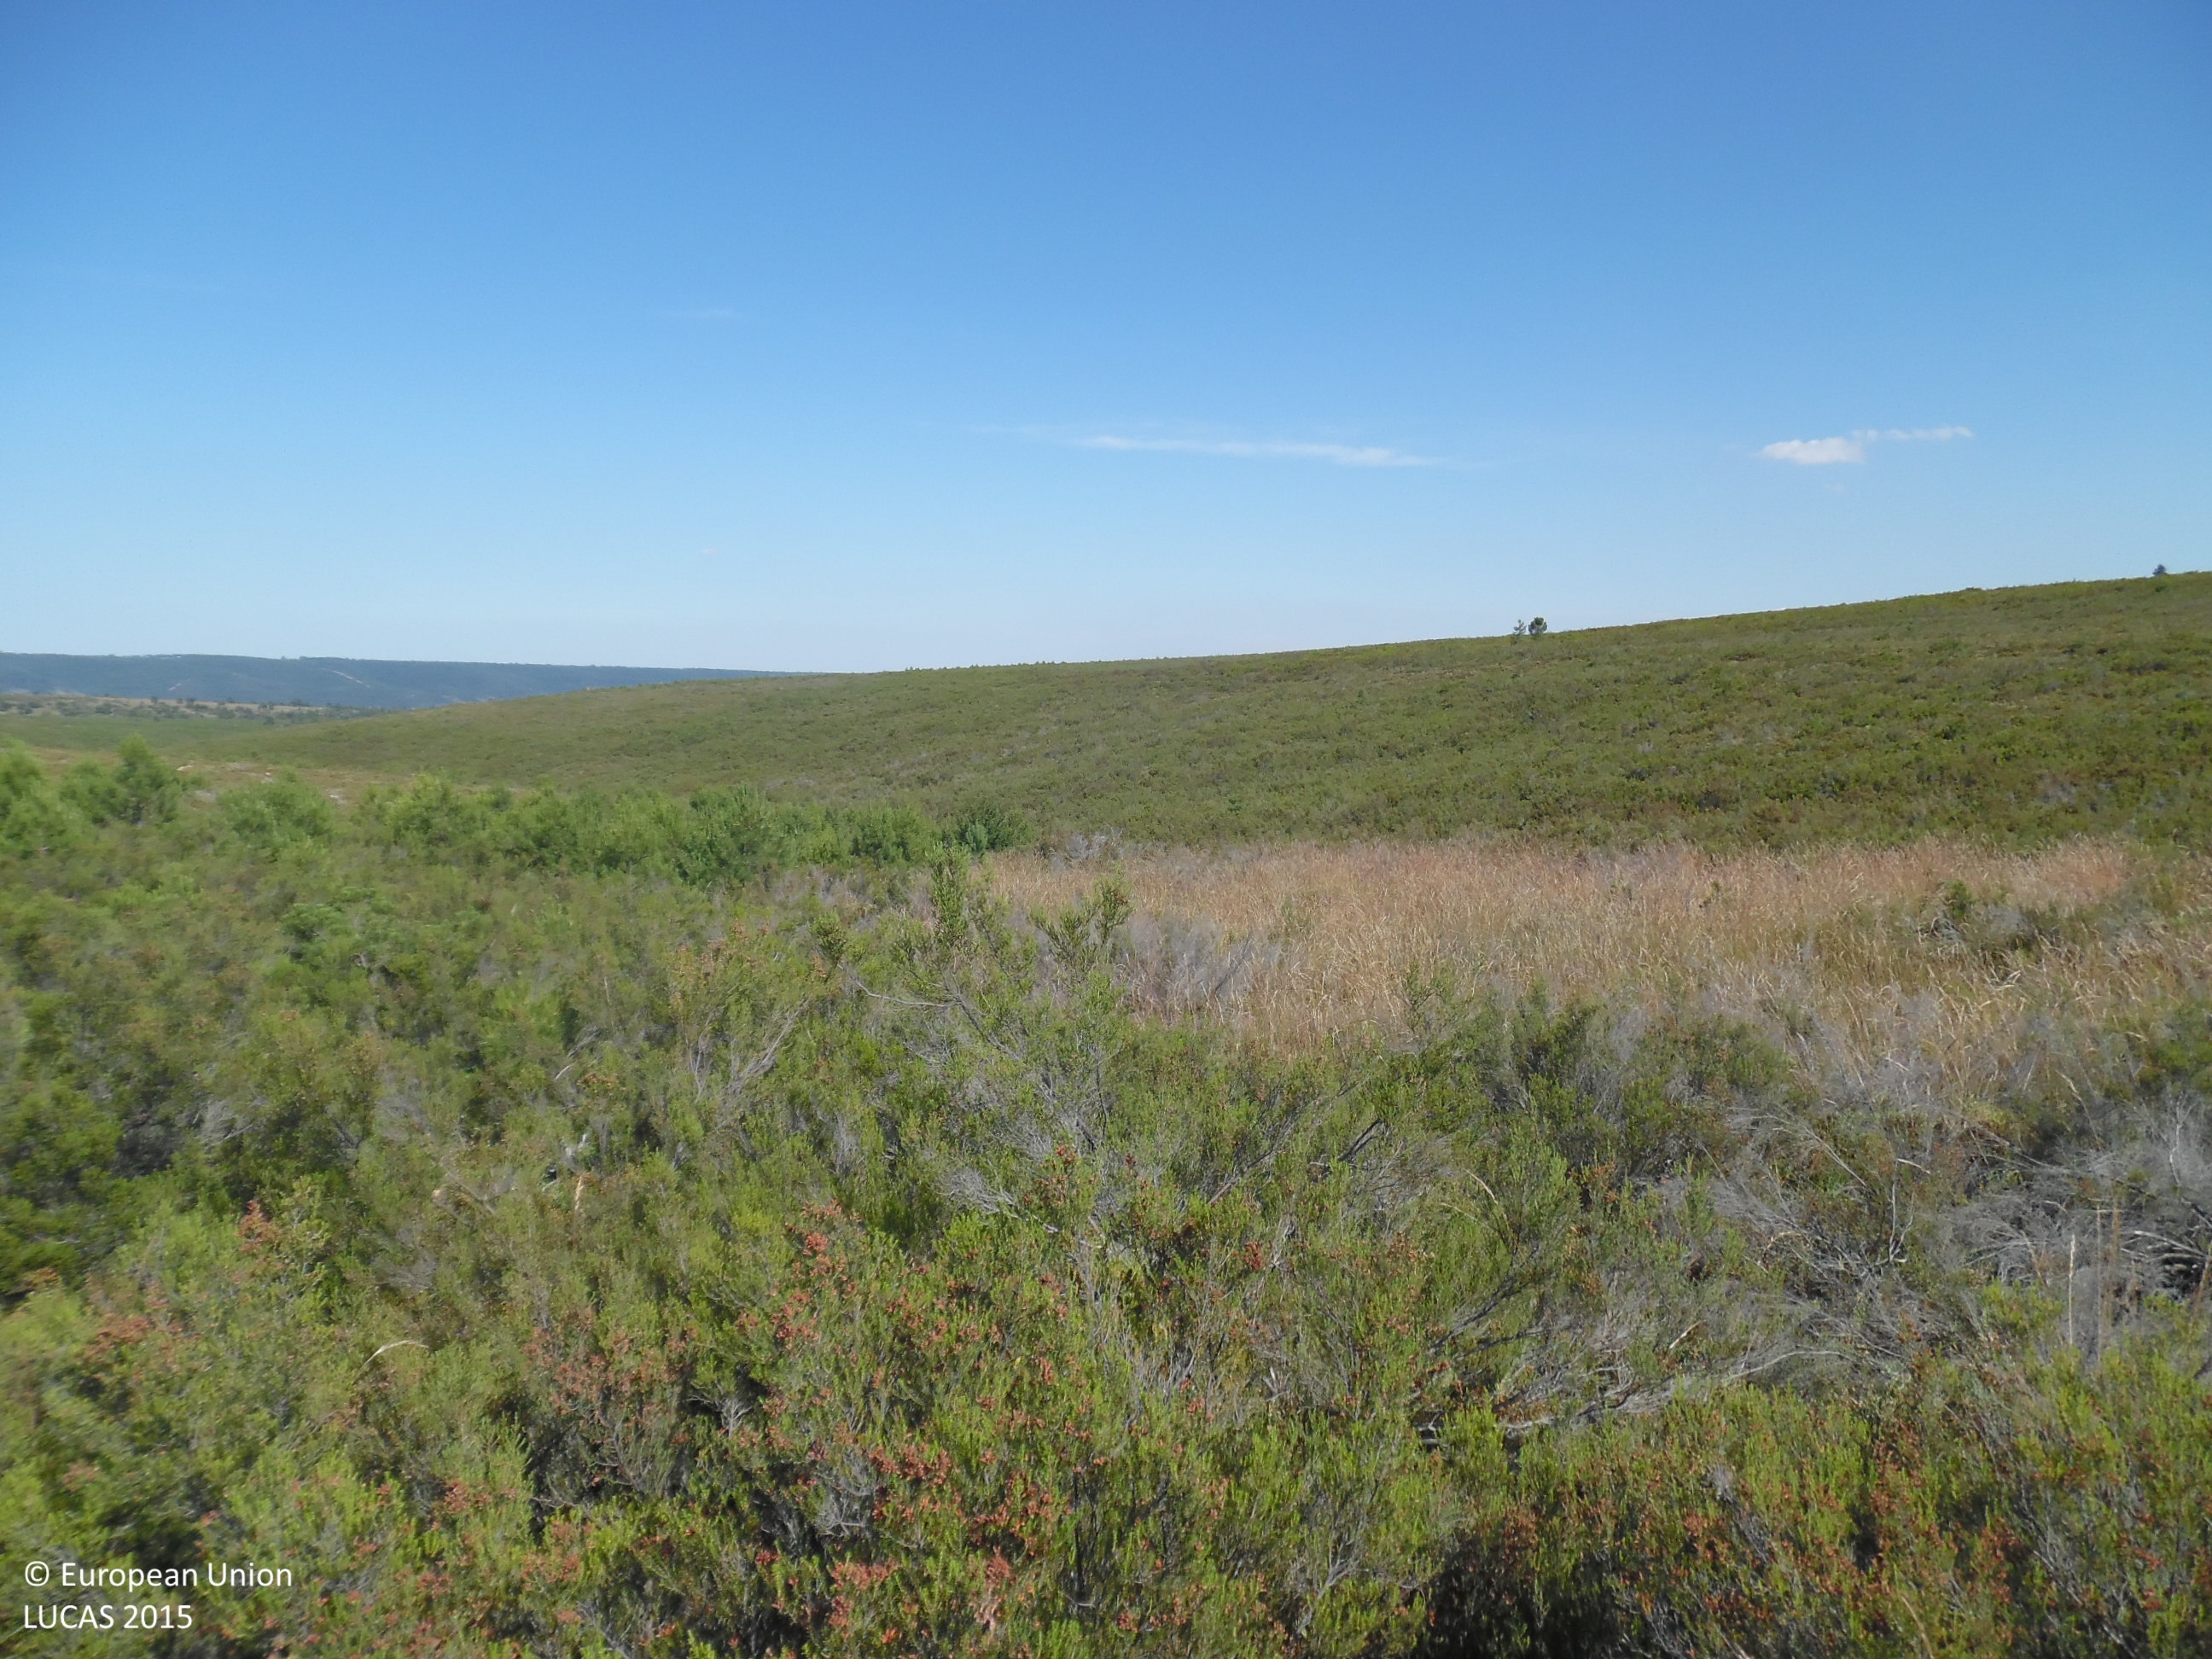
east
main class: Shrubland
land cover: Shrubland without tree cover
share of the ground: > 75 %
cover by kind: shrubs 100 %
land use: Forestry
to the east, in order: Shrubland without tree cover; Pine dominated coniferous woodland; Shrubland without tree cover
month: June
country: ES
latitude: 42.7249
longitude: -5.6966
